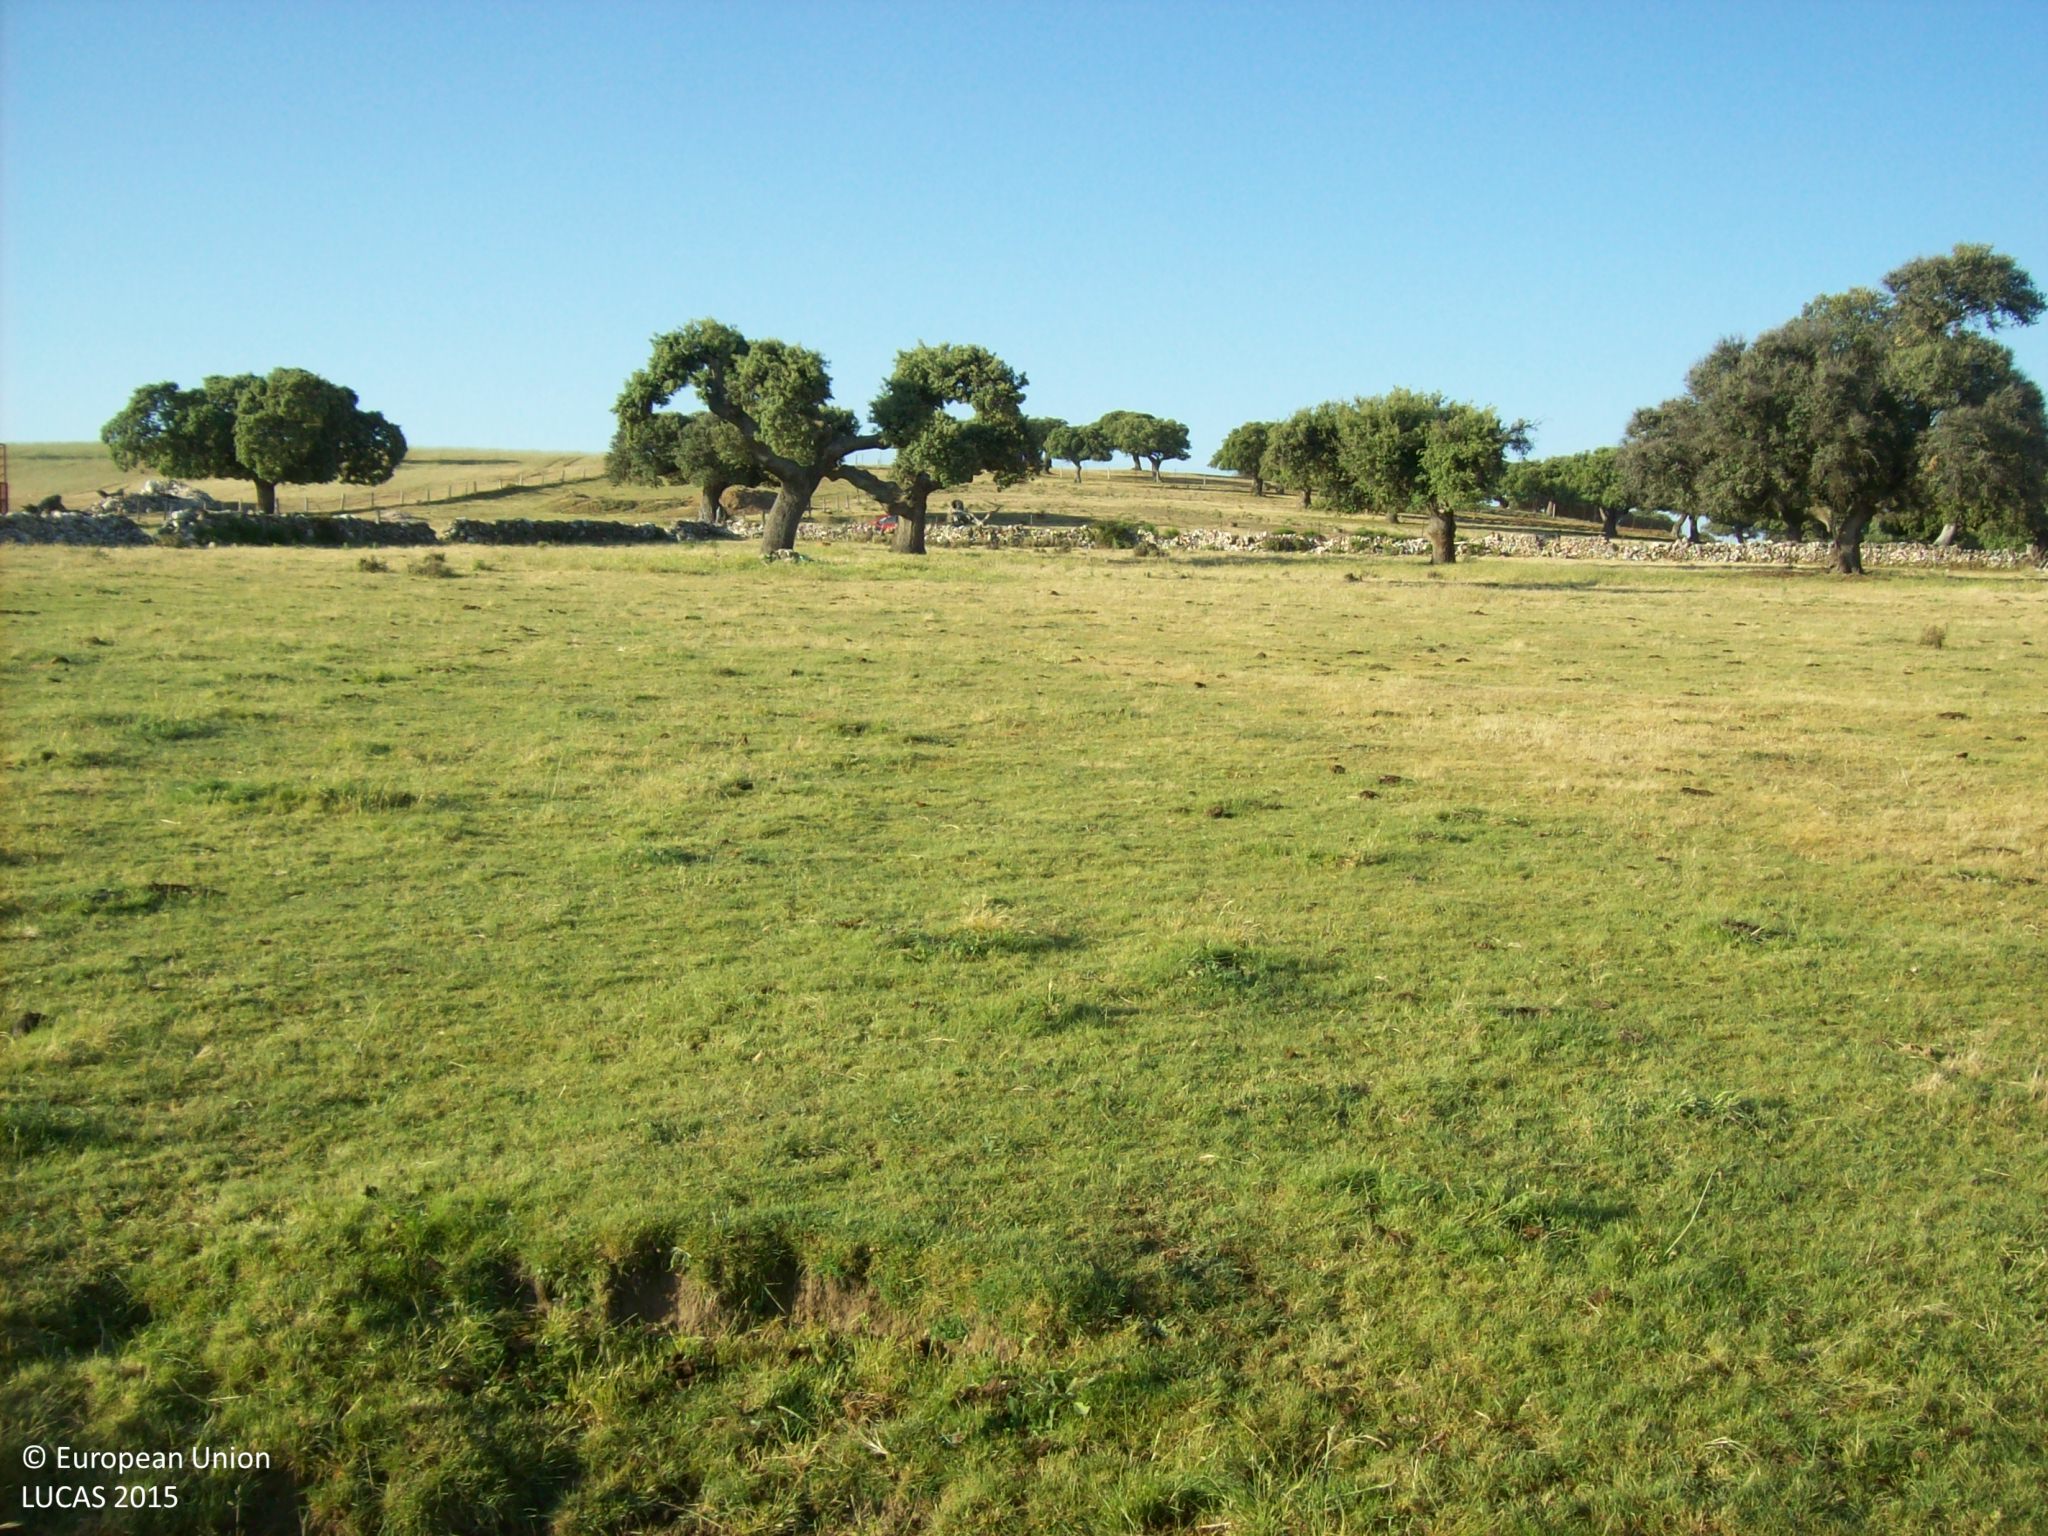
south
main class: Grassland
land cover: Grassland without tree/shrub cover
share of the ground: > 75 %
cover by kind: herbaceous plants 100 %
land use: Agriculture (excluding fallow land and kitchen gardens)
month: May
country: ES
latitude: 40.7591
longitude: -5.1197
